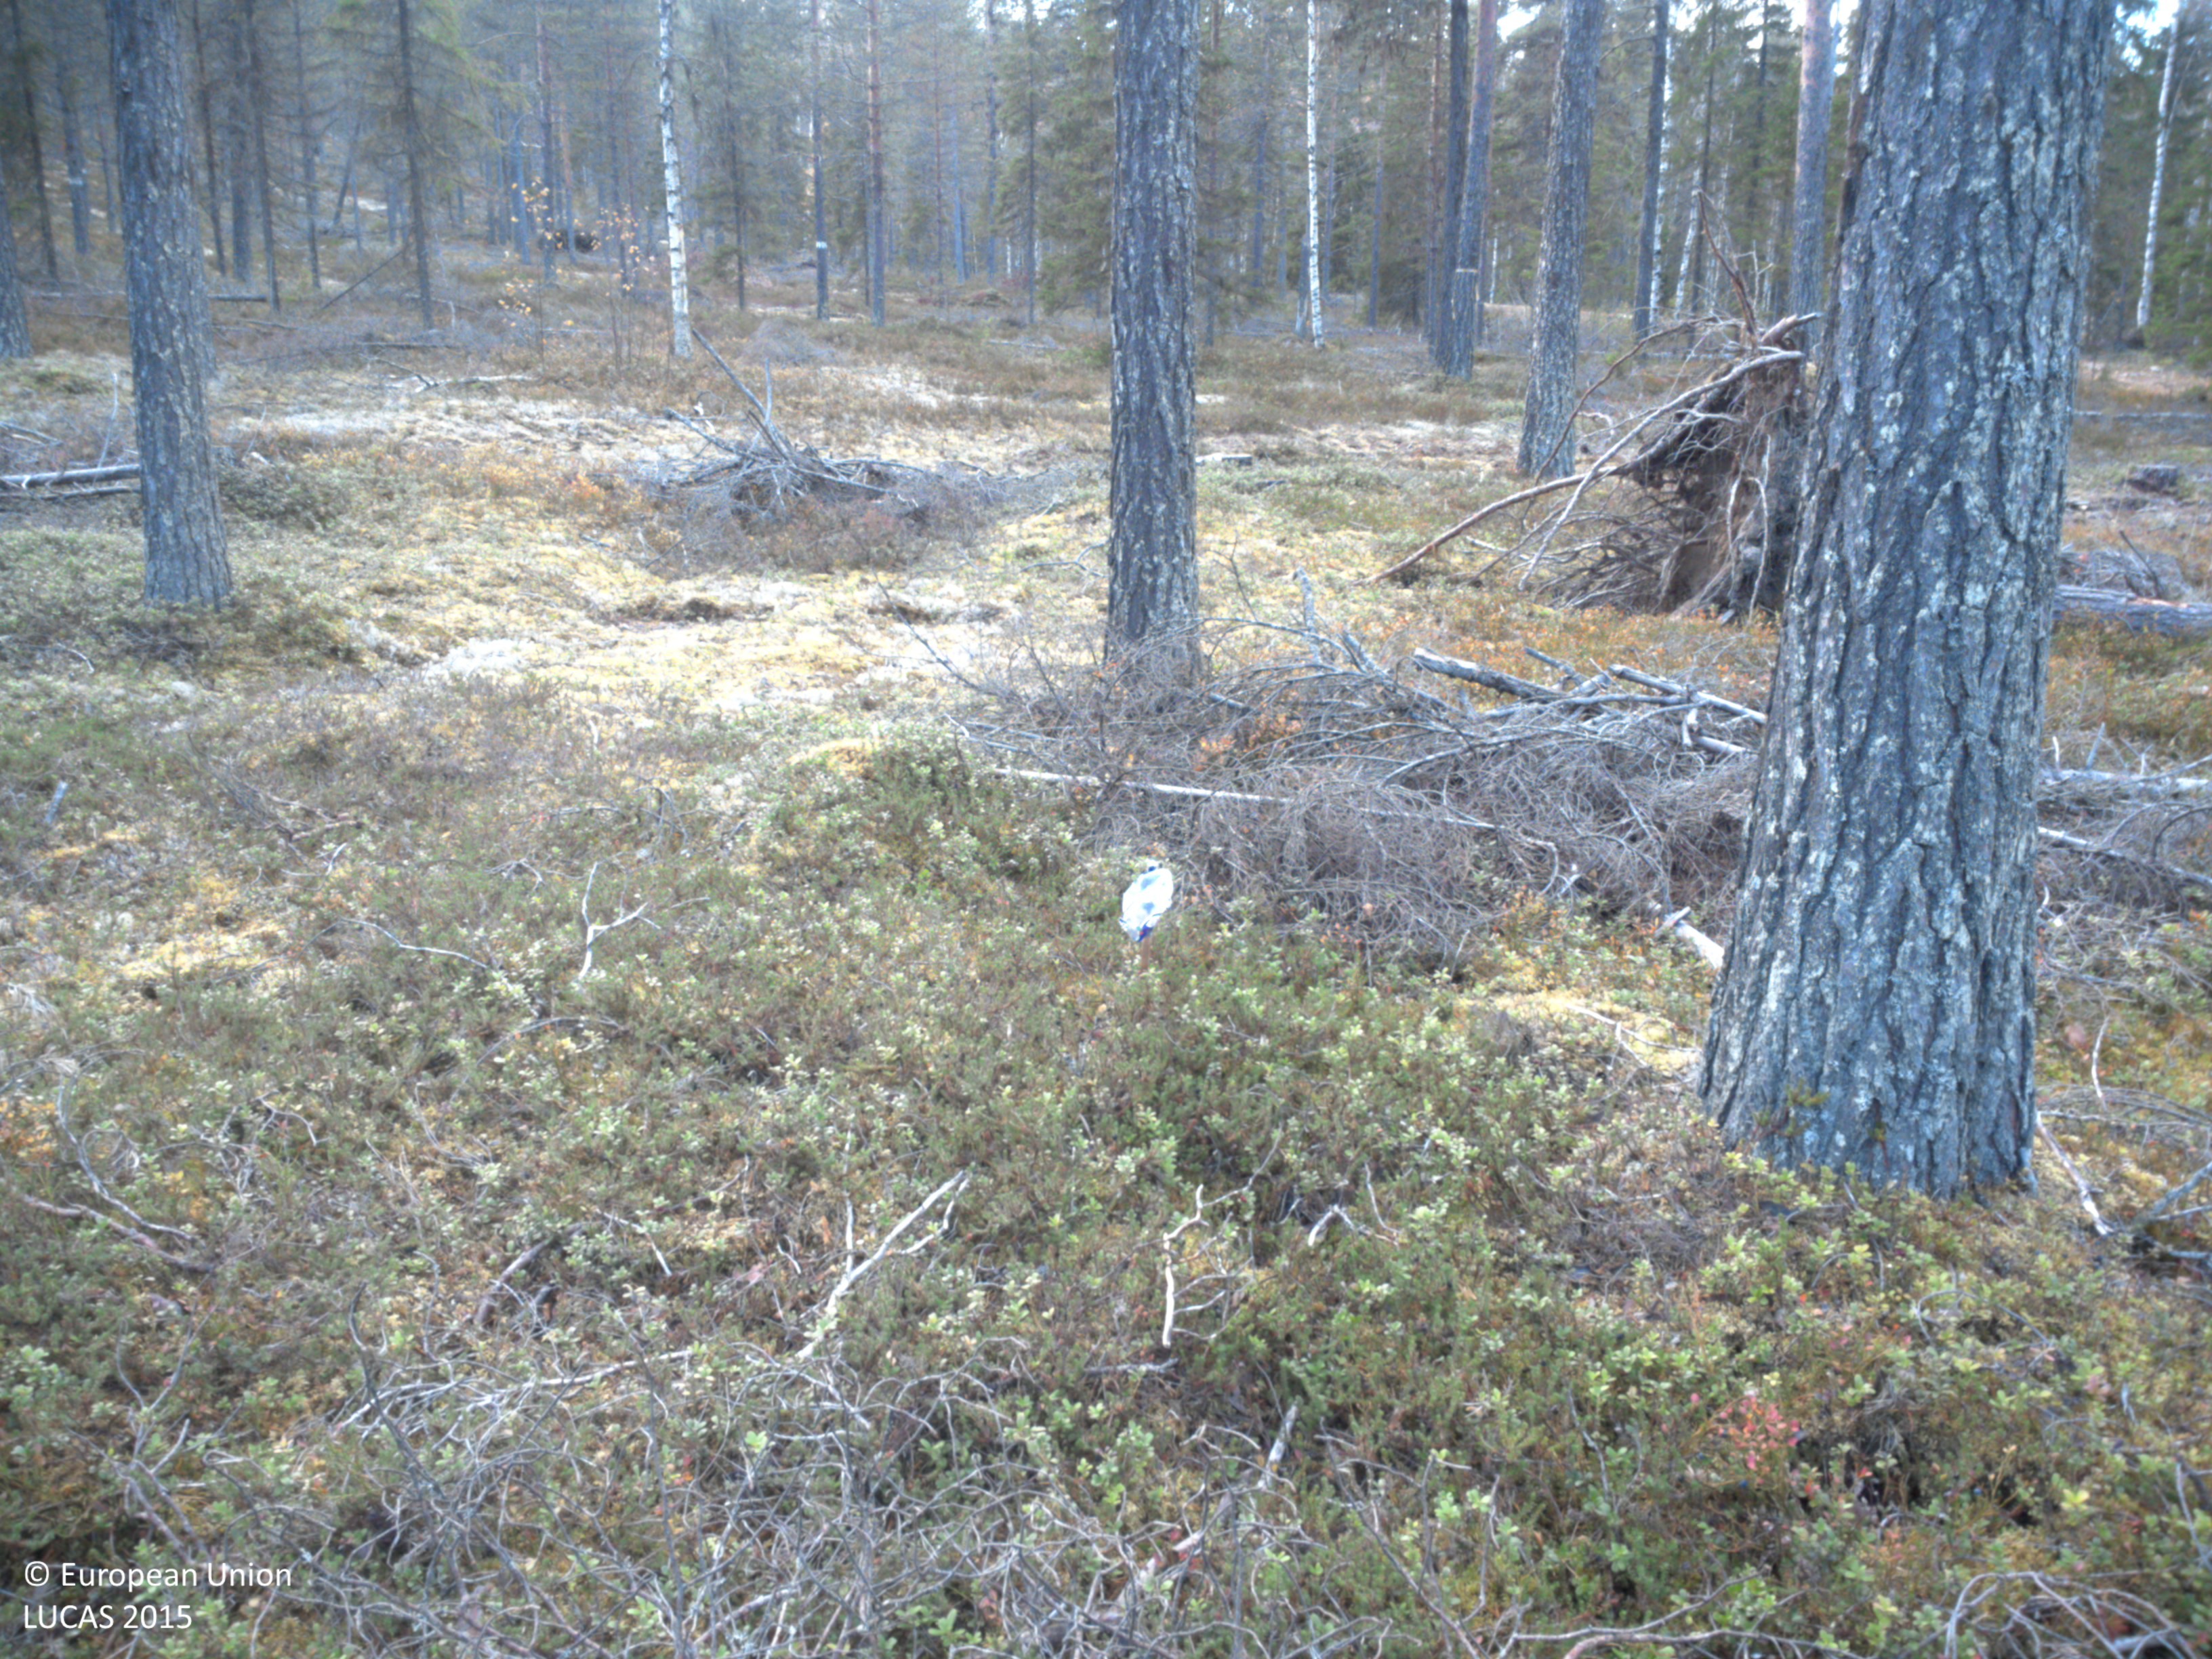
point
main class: Woodland
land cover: Pine dominated coniferous woodland
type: boreal forest
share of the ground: 50 - 75 %
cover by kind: coniferous forest trees 75 %, shrubs 10 %, lichens and mosses 10 %, herbaceous plants 5 %
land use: Forestry
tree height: > 5 m
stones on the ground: < 10 %
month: October
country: SE
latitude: 63.9529
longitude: 18.8117
